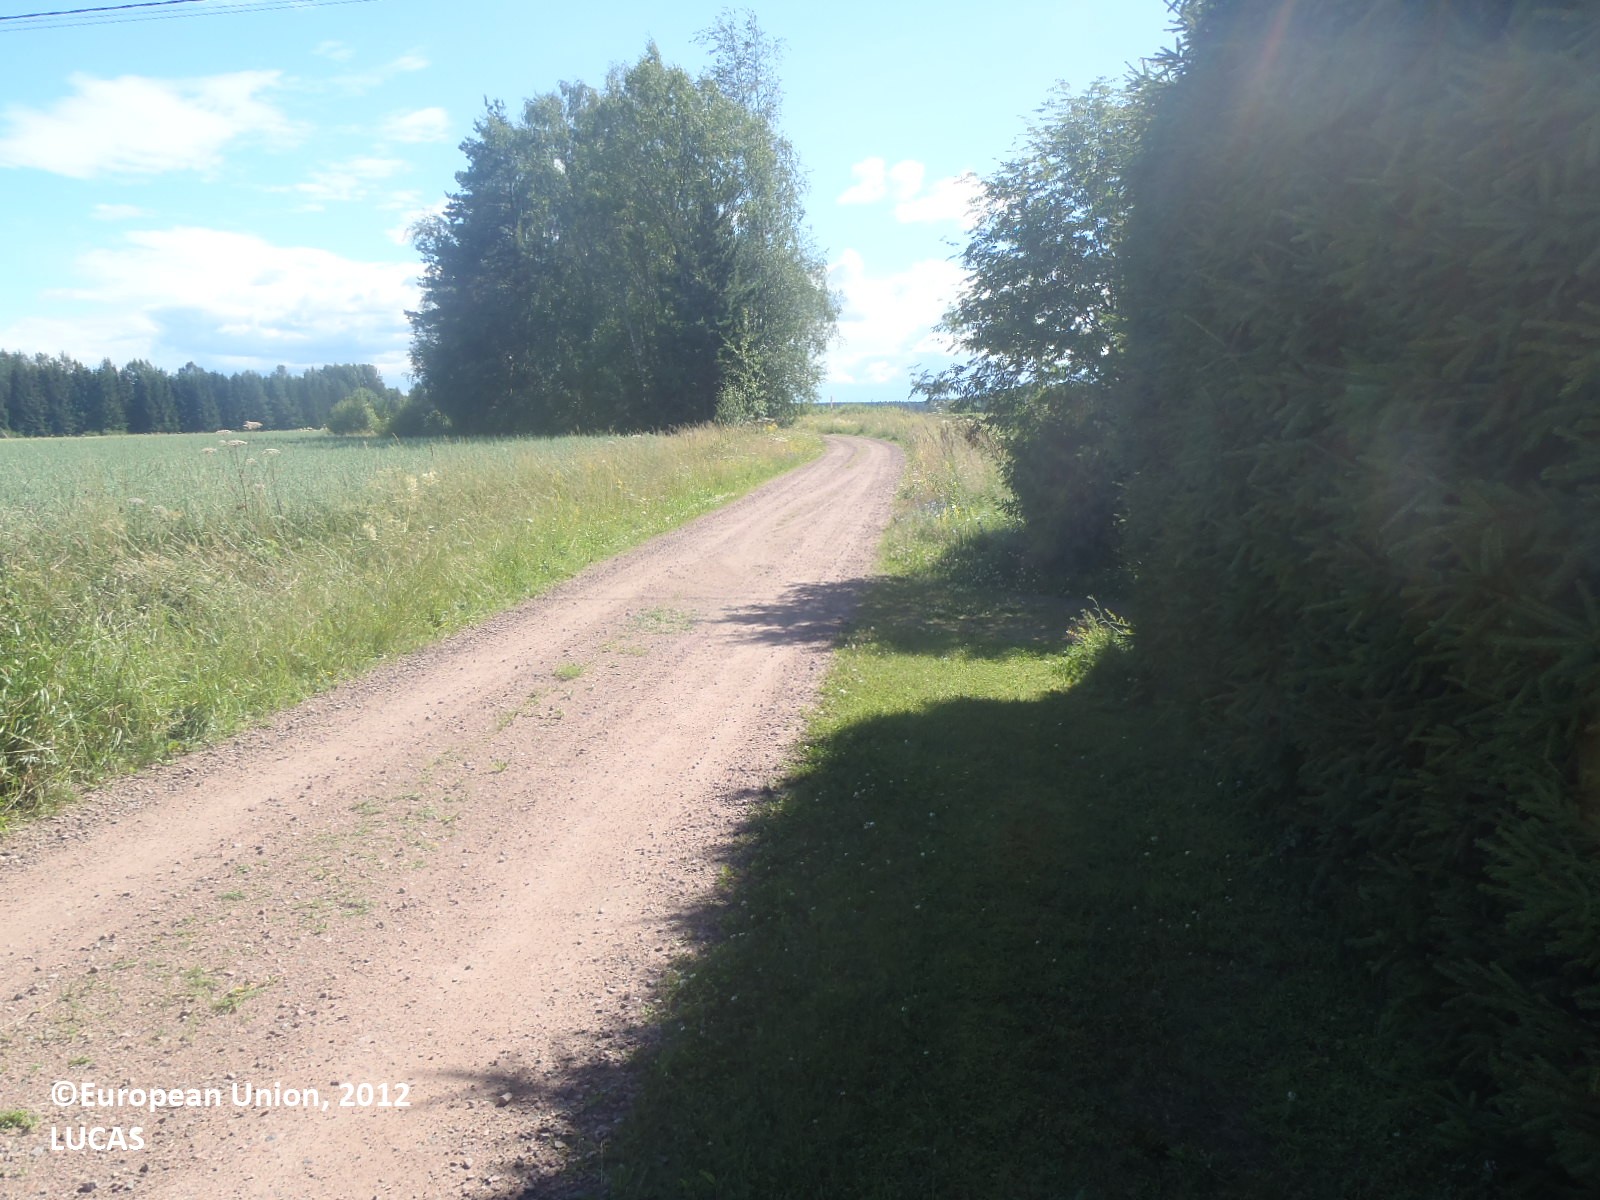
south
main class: Woodland
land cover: Spruce dominated coniferous woodland
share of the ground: > 75 %
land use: Residential
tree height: < 5 m
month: July
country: FI
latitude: 61.1940
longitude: 22.0593
